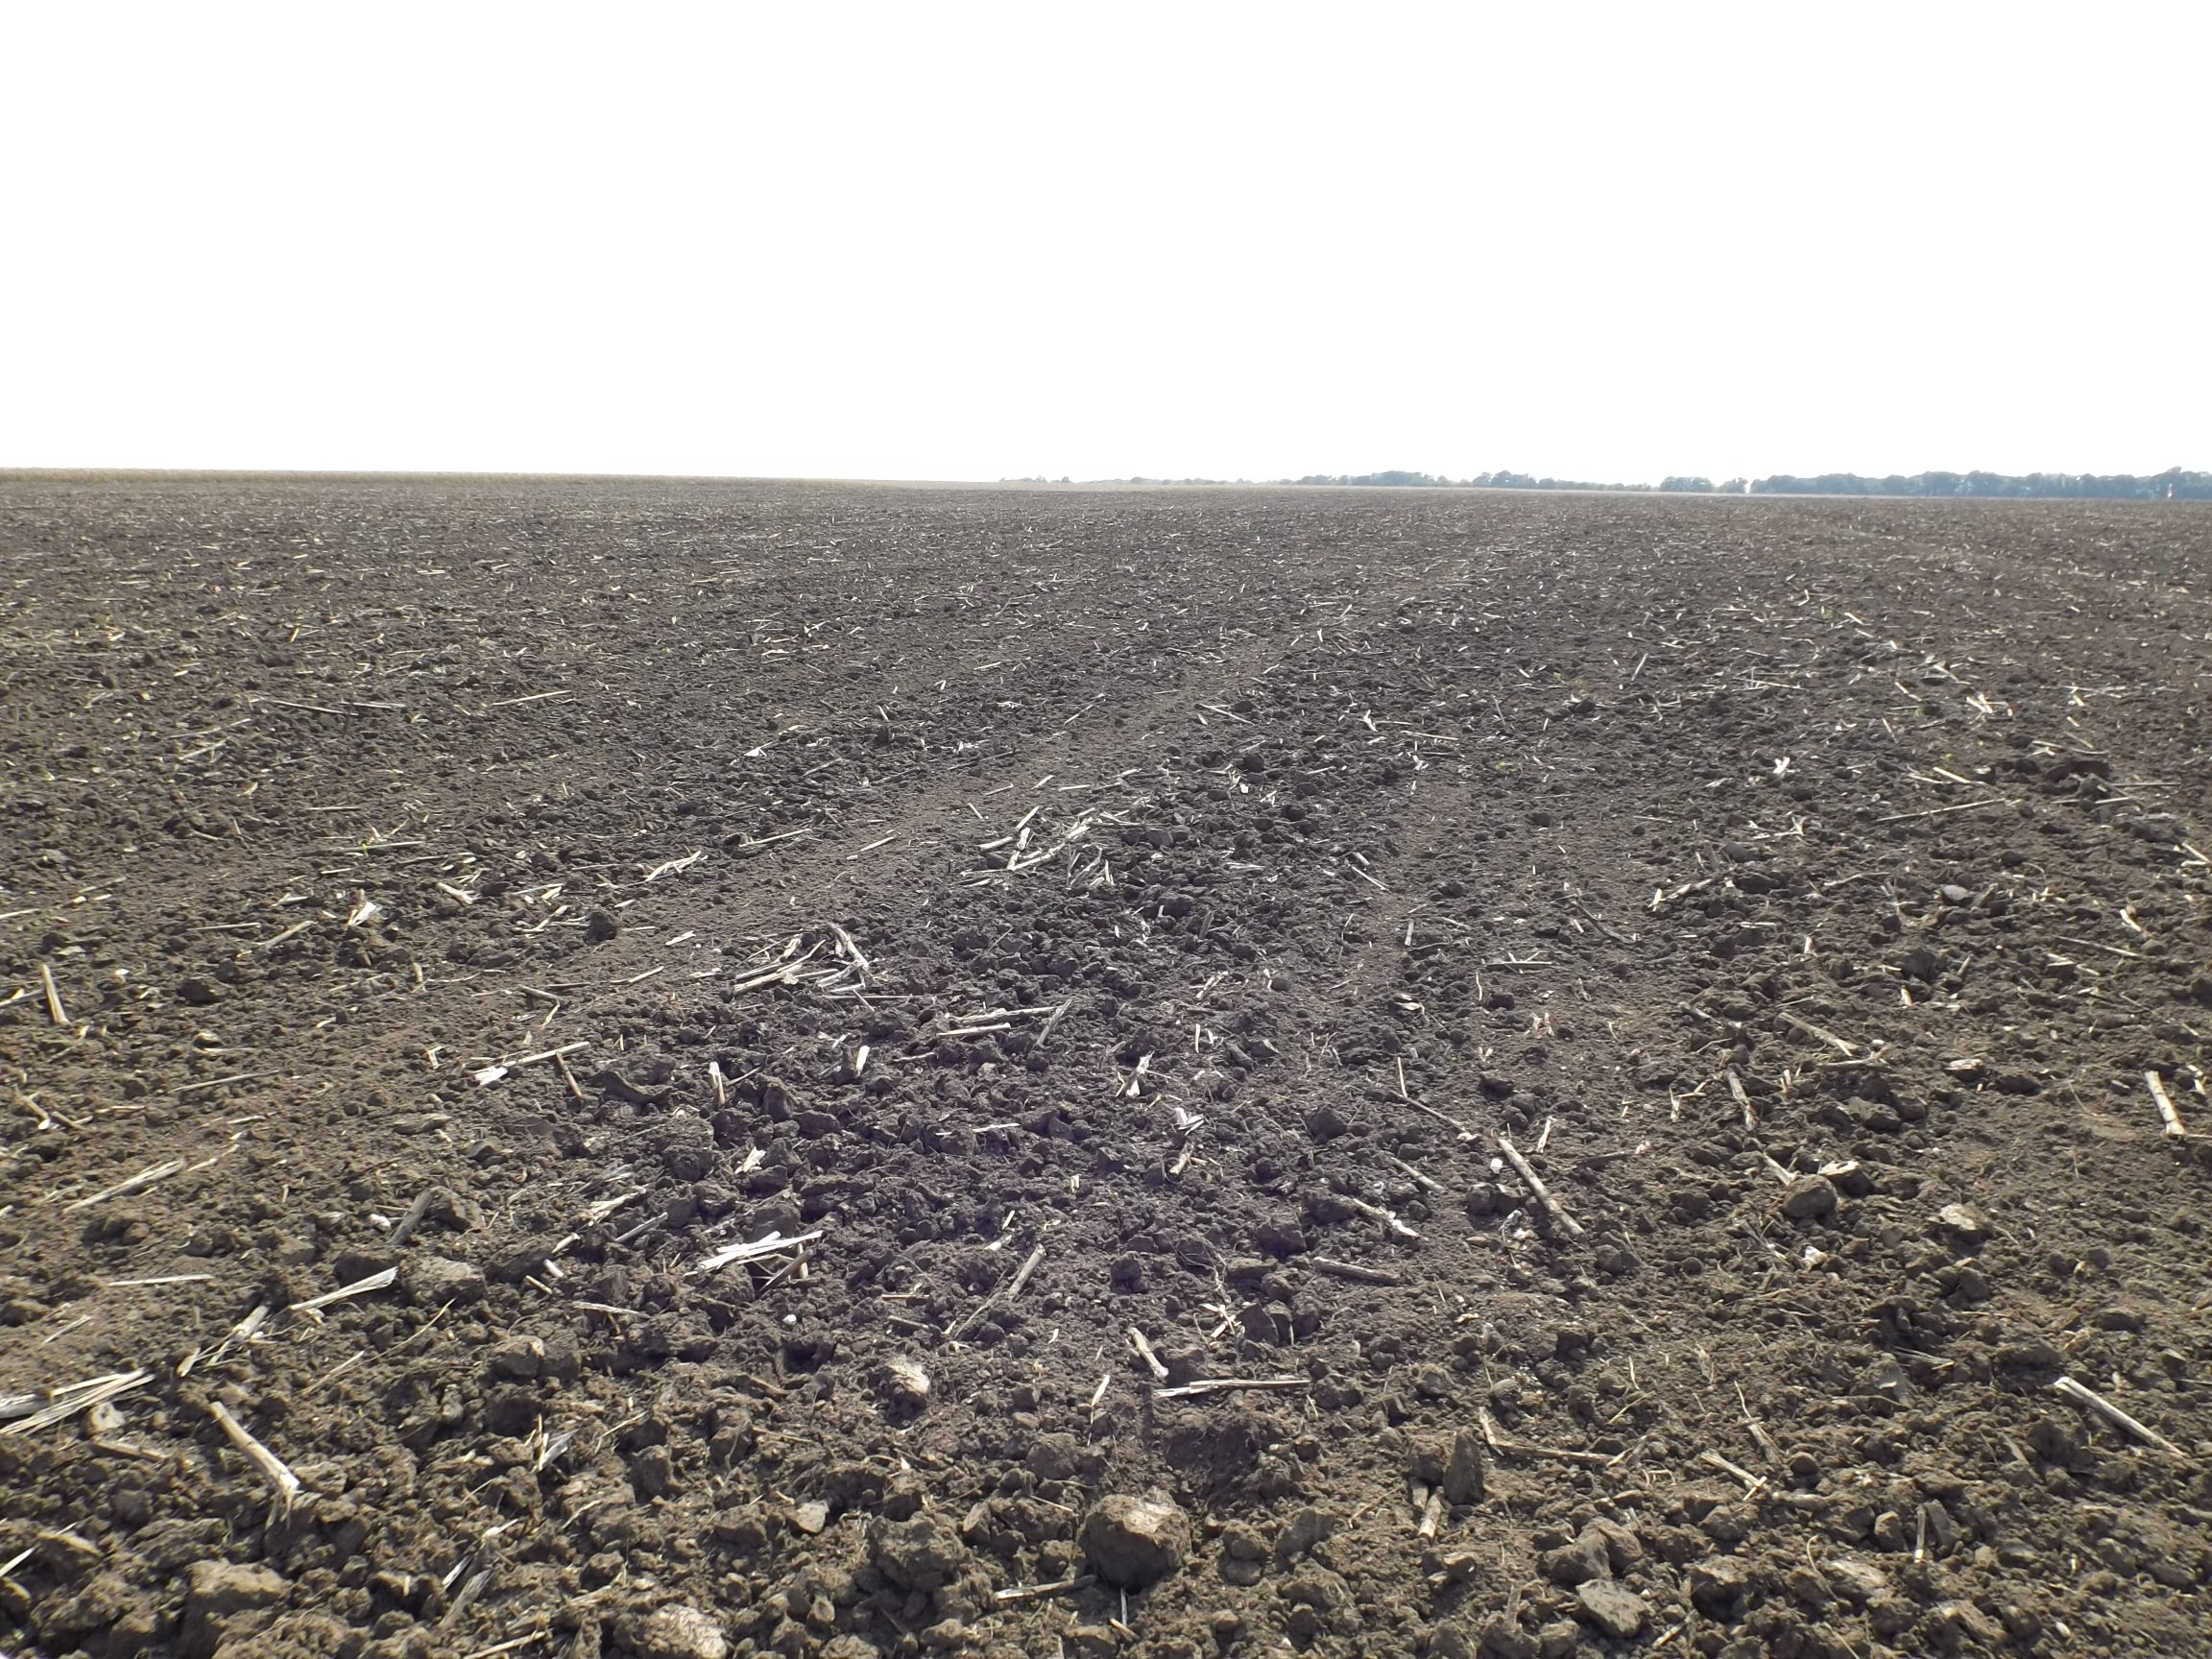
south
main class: Cropland
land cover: Sunflower
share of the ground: < 10 %
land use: Agriculture (excluding fallow land and kitchen gardens)
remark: Harvested field
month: September
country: BG
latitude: 43.9922
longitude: 26.8402
